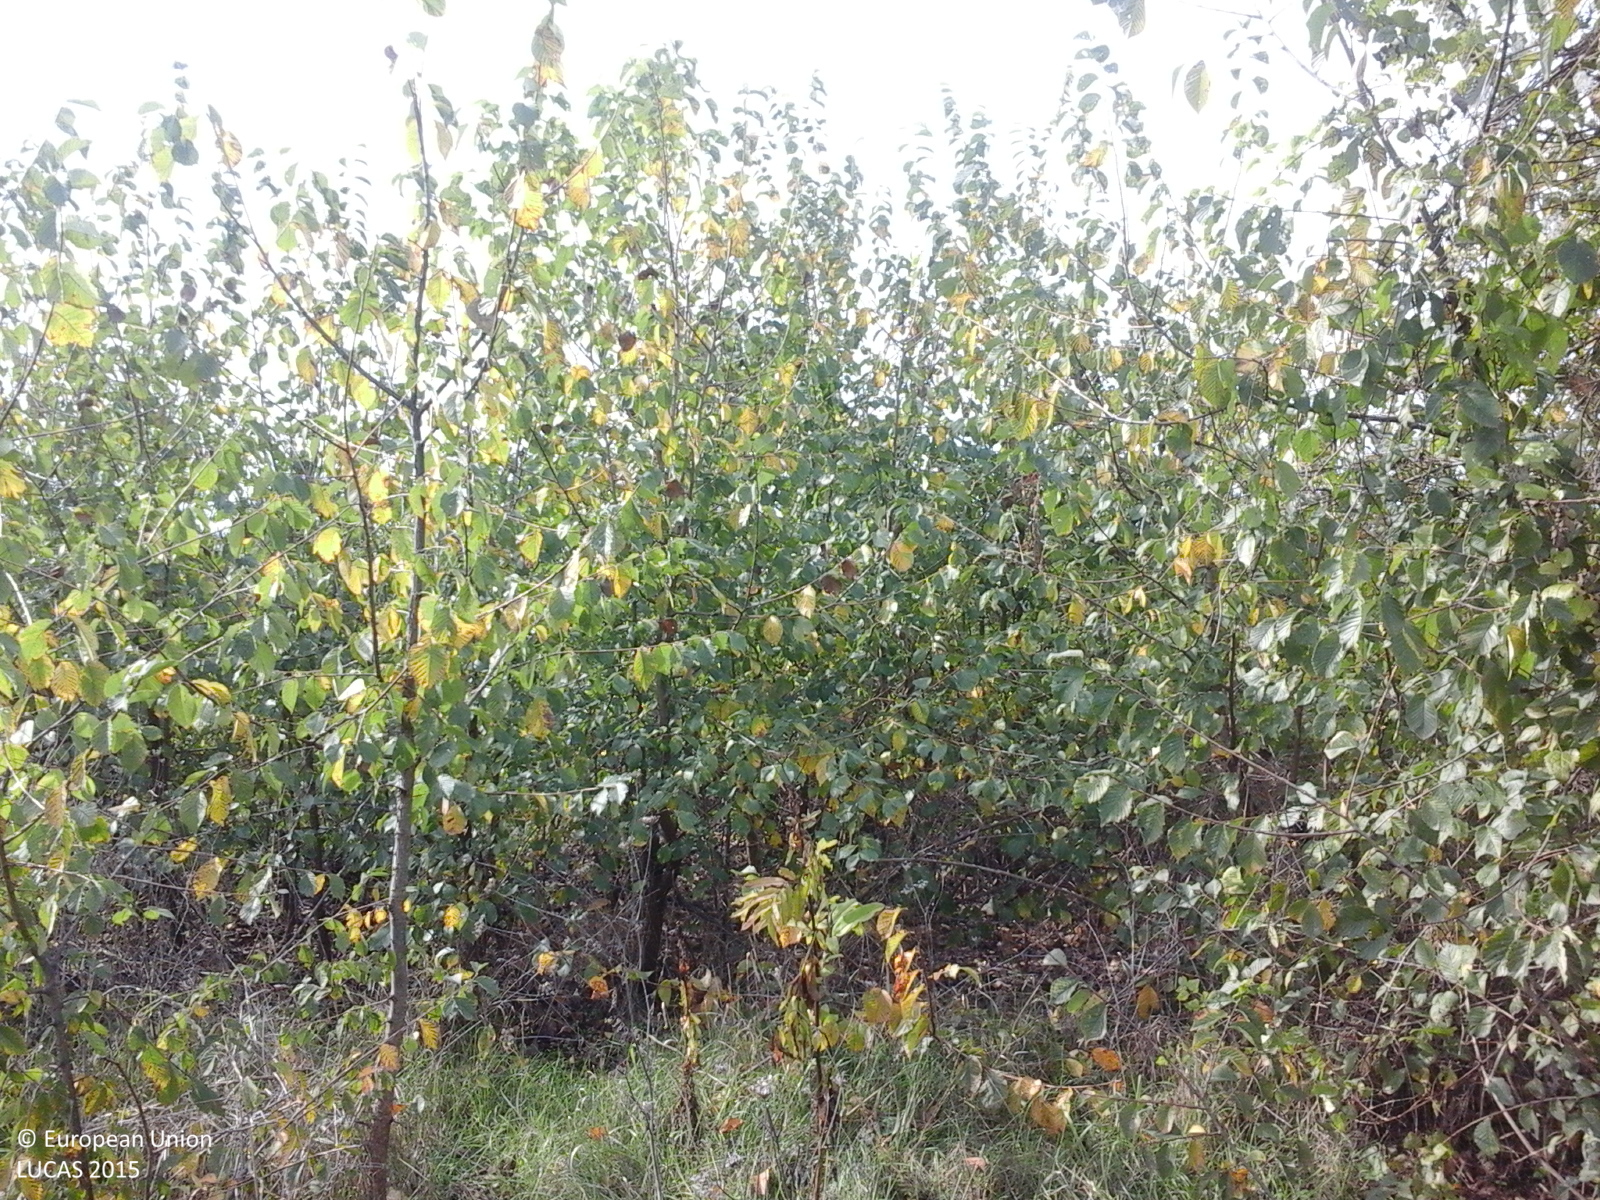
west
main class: Grassland
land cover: Grassland with sparse tree/shrub cover
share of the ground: > 75 %
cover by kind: herbaceous plants 85 %, shrubs 10 %, broadleaved forest trees 5 %
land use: Fallow land
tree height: < 5 m
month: October
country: RO
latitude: 44.9921
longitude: 26.1054
